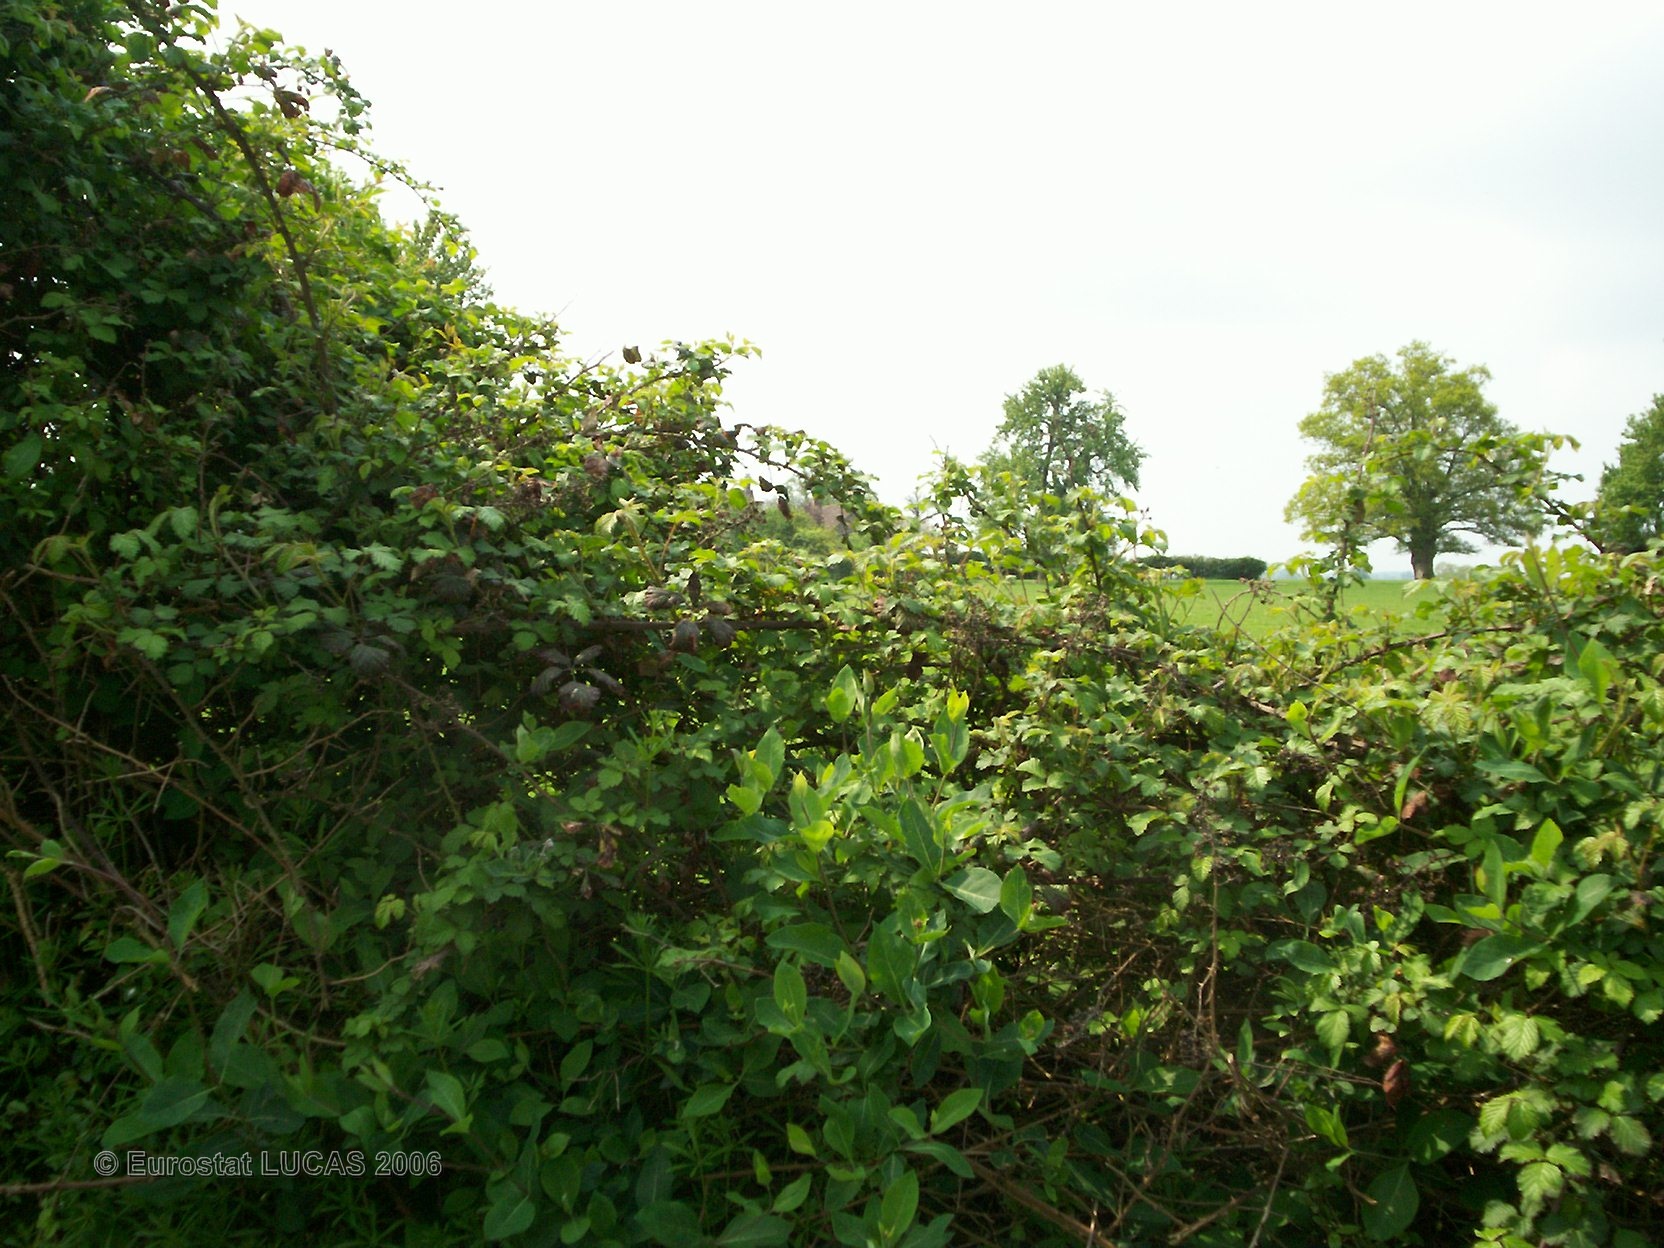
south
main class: Grassland
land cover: Grassland without tree/shrub cover
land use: Agriculture (excluding fallow land and kitchen gardens)
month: May
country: FR
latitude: 48.5096
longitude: 0.1855
